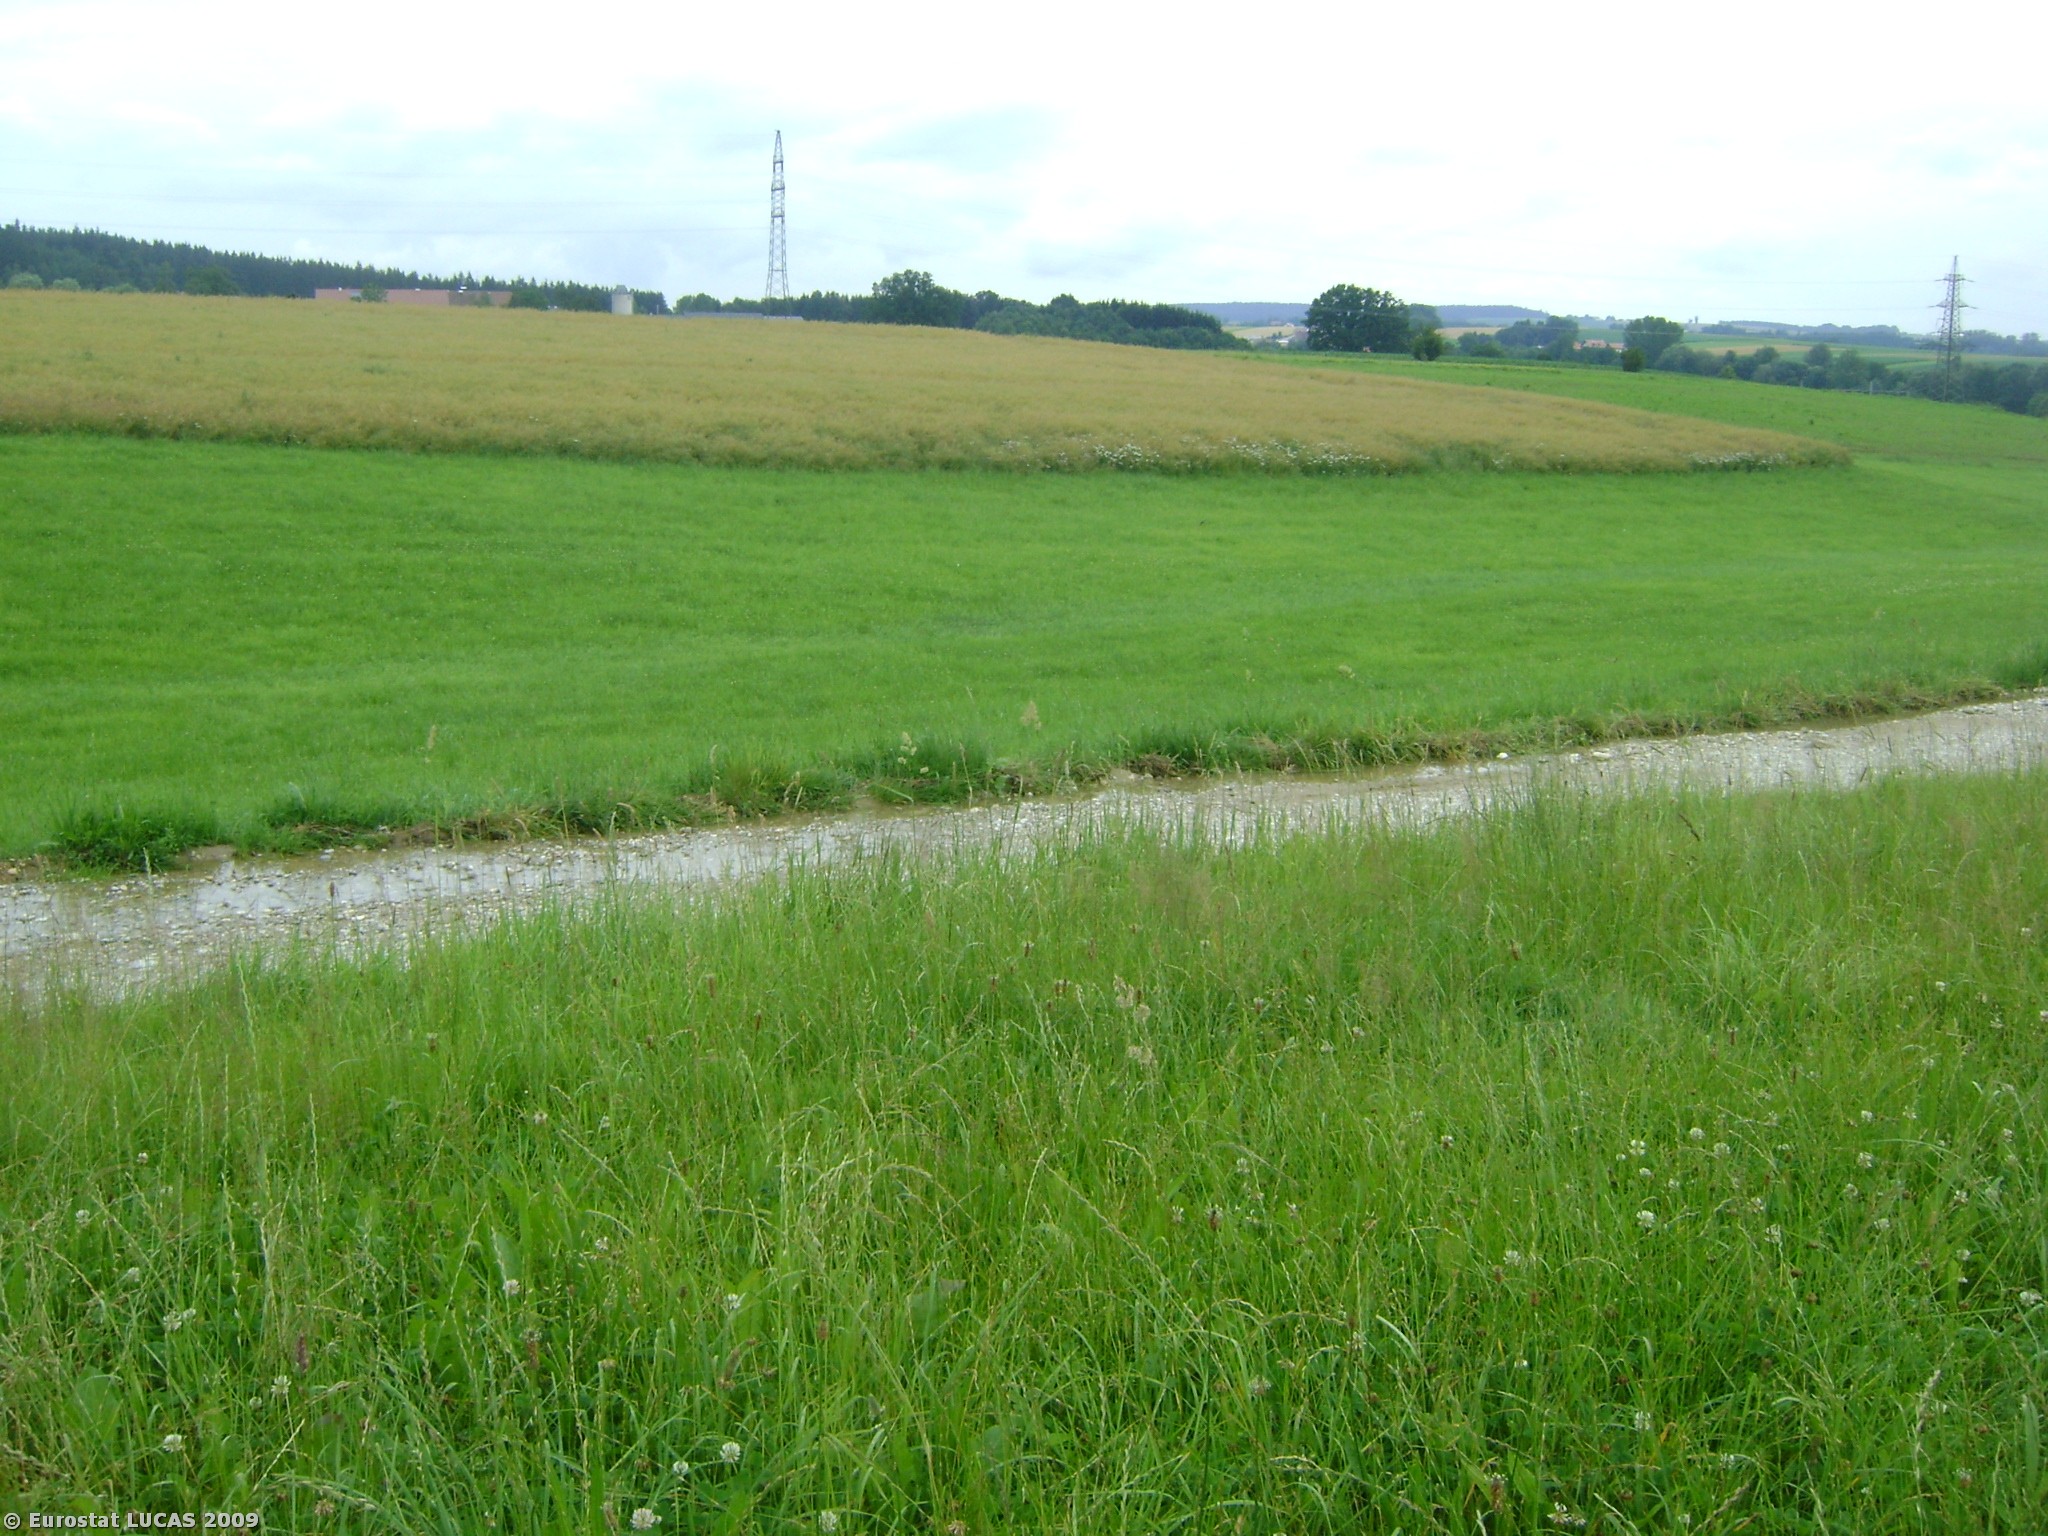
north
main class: Grassland
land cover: Grassland without tree/shrub cover
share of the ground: > 75 %
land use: Agriculture (excluding fallow land and kitchen gardens)
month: July
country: AT
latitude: 48.1931
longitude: 13.2681
